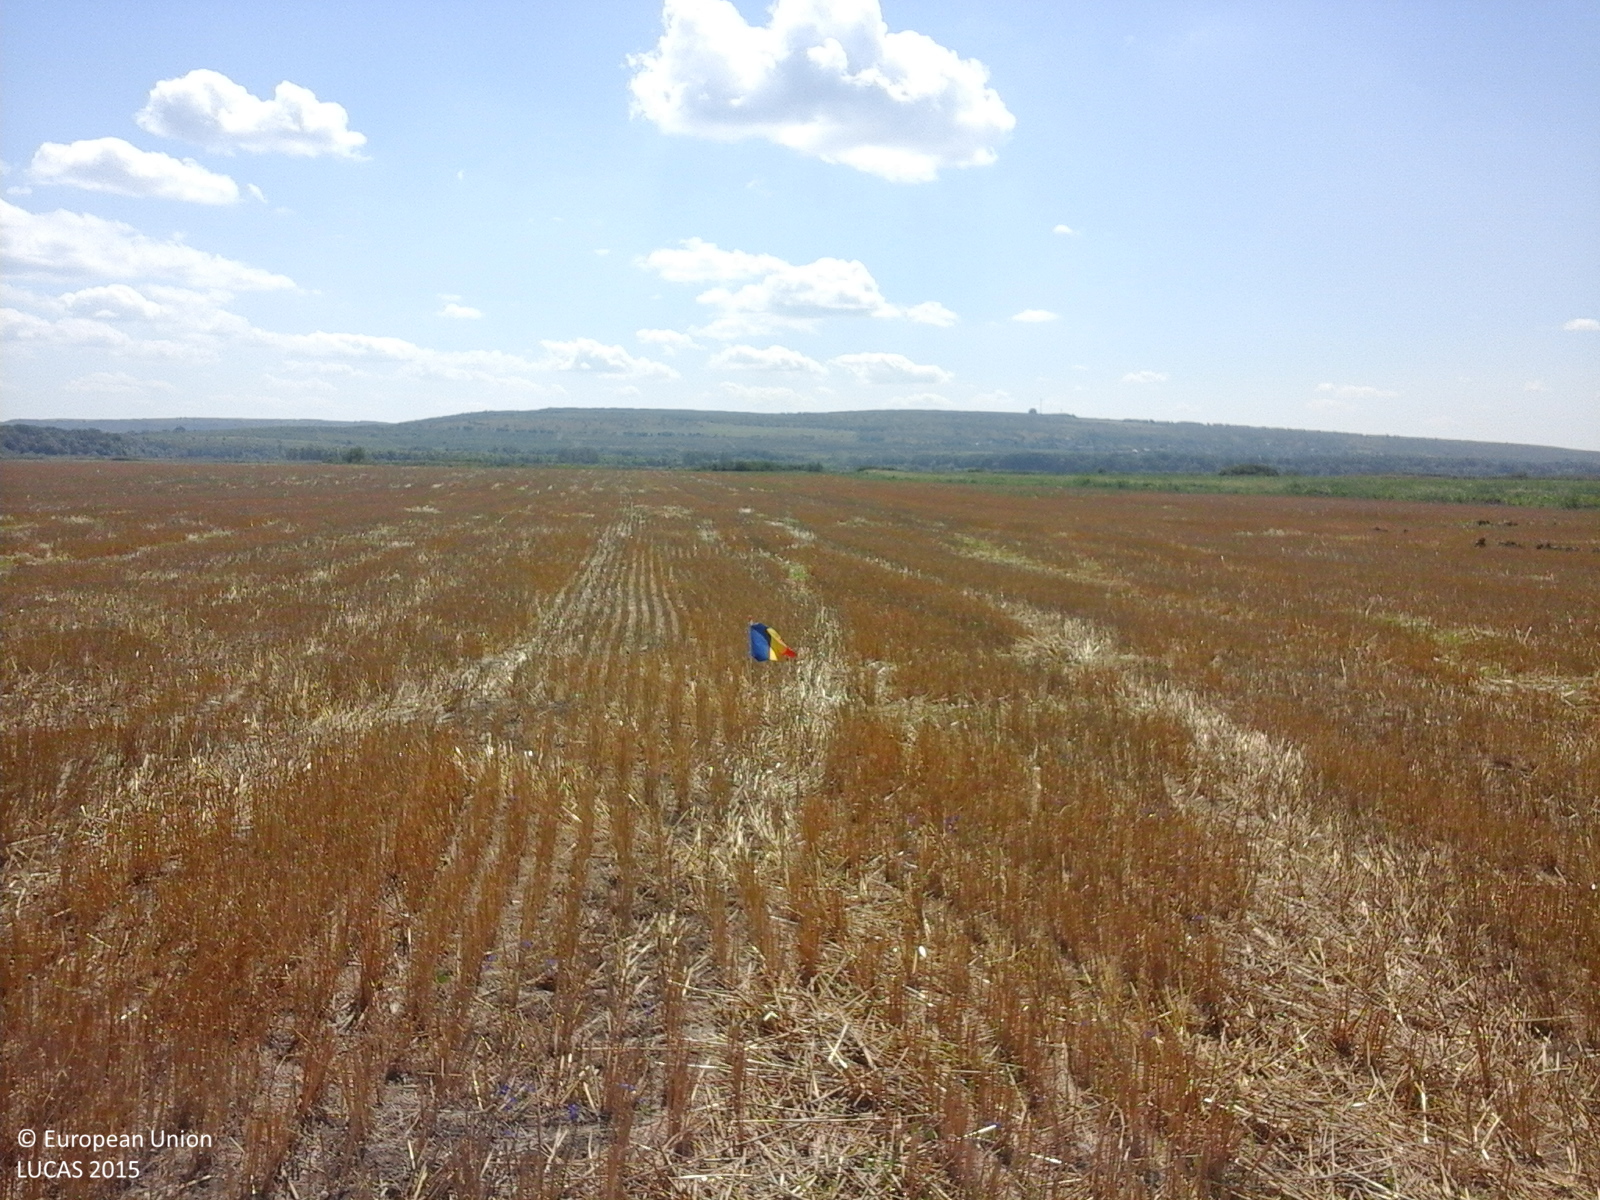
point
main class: Cropland
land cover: Common wheat
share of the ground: 50 - 75 %
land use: Agriculture (excluding fallow land and kitchen gardens)
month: July
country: RO
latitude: 46.3964
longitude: 28.1968
